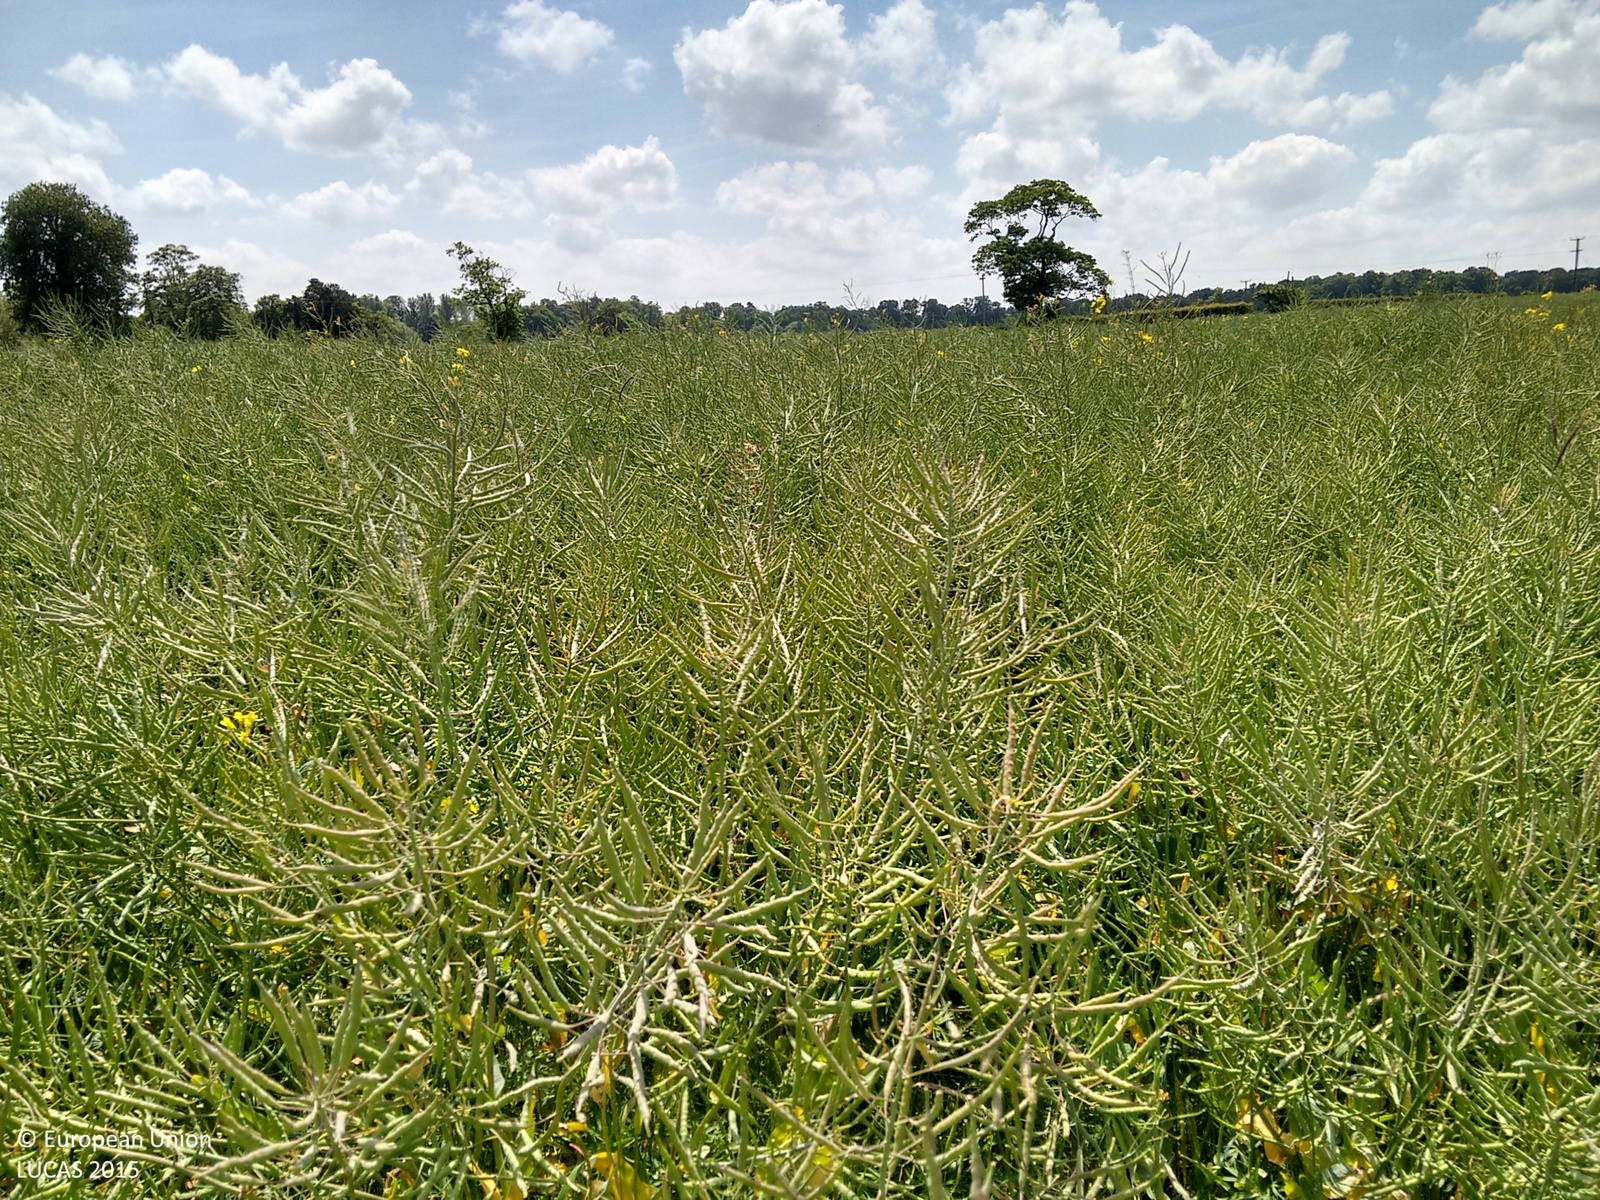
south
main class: Cropland
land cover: Rape and turnip rape
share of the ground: > 75 %
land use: Agriculture (excluding fallow land and kitchen gardens)
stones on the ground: < 10 %
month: June
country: GB
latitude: 52.9515
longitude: -0.6217
